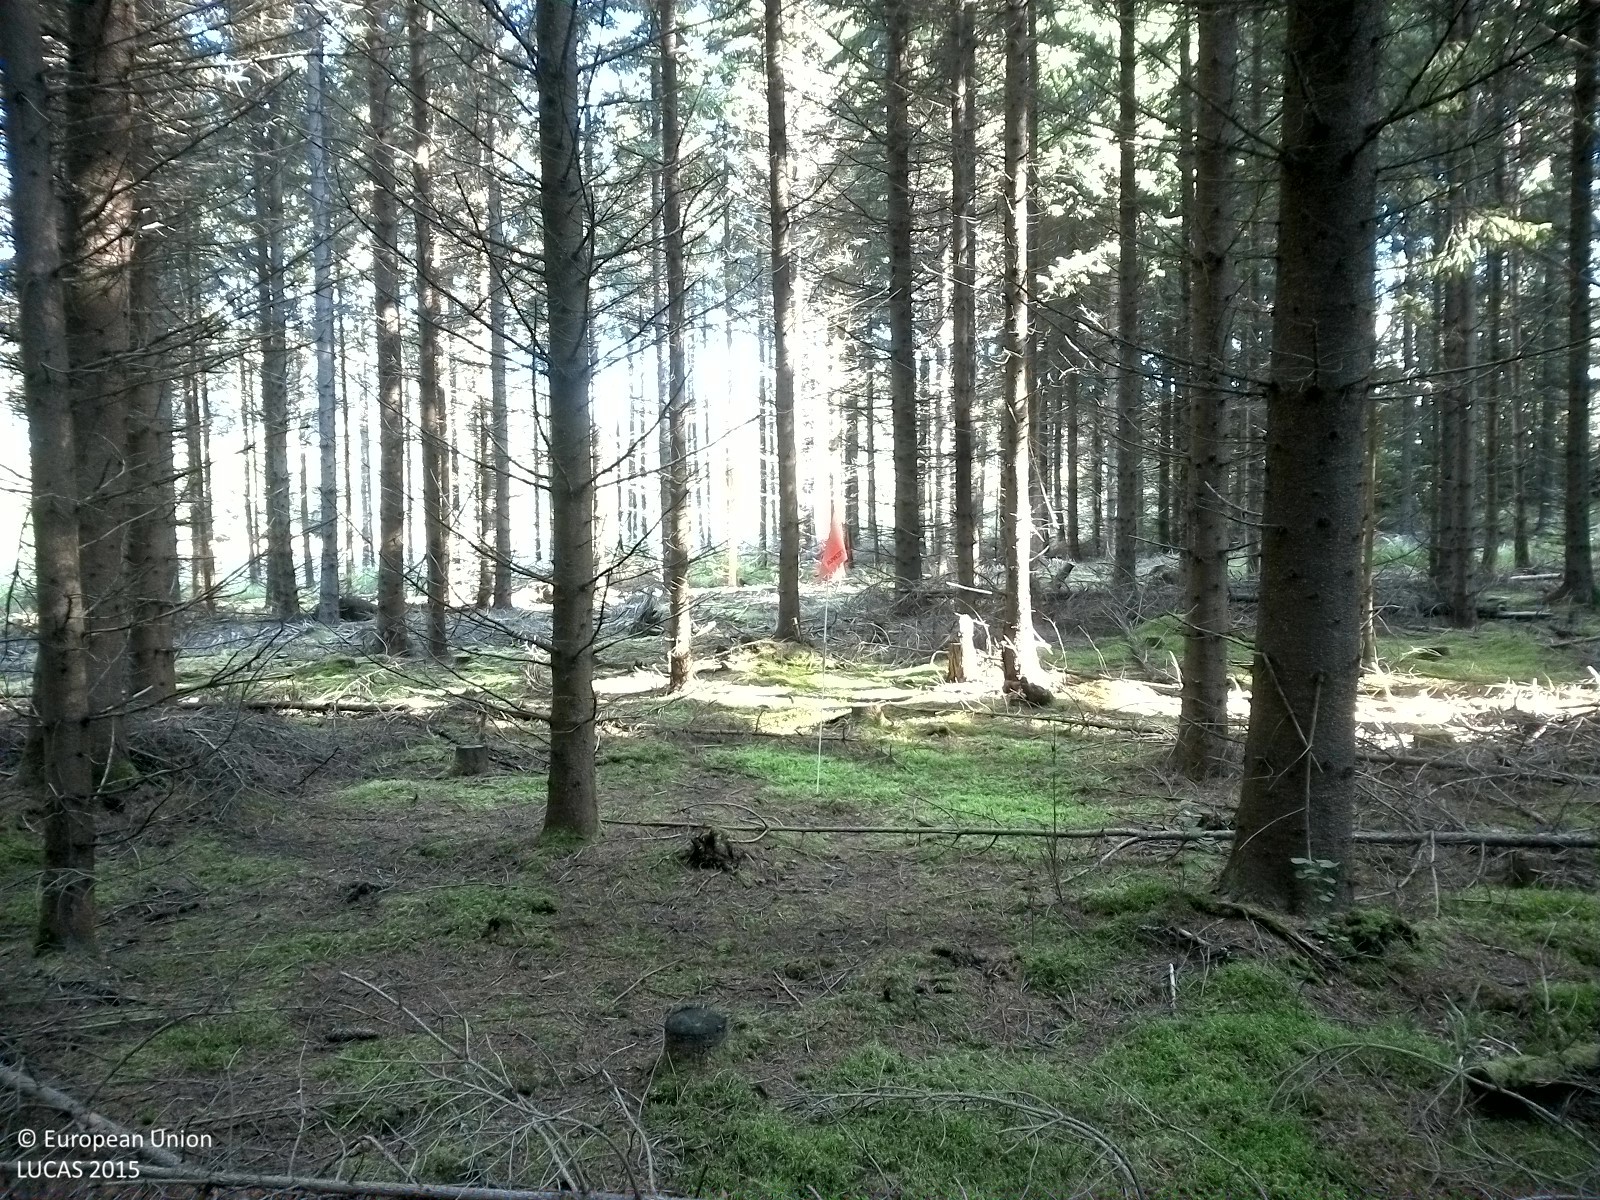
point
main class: Woodland
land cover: Spruce dominated coniferous woodland
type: boreal forest
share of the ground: 50 - 75 %
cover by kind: coniferous forest trees 65 %, lichens and mosses 30 %, herbaceous plants 5 %
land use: Forestry
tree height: > 5 m
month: August
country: SE
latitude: 59.0449
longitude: 15.0295
